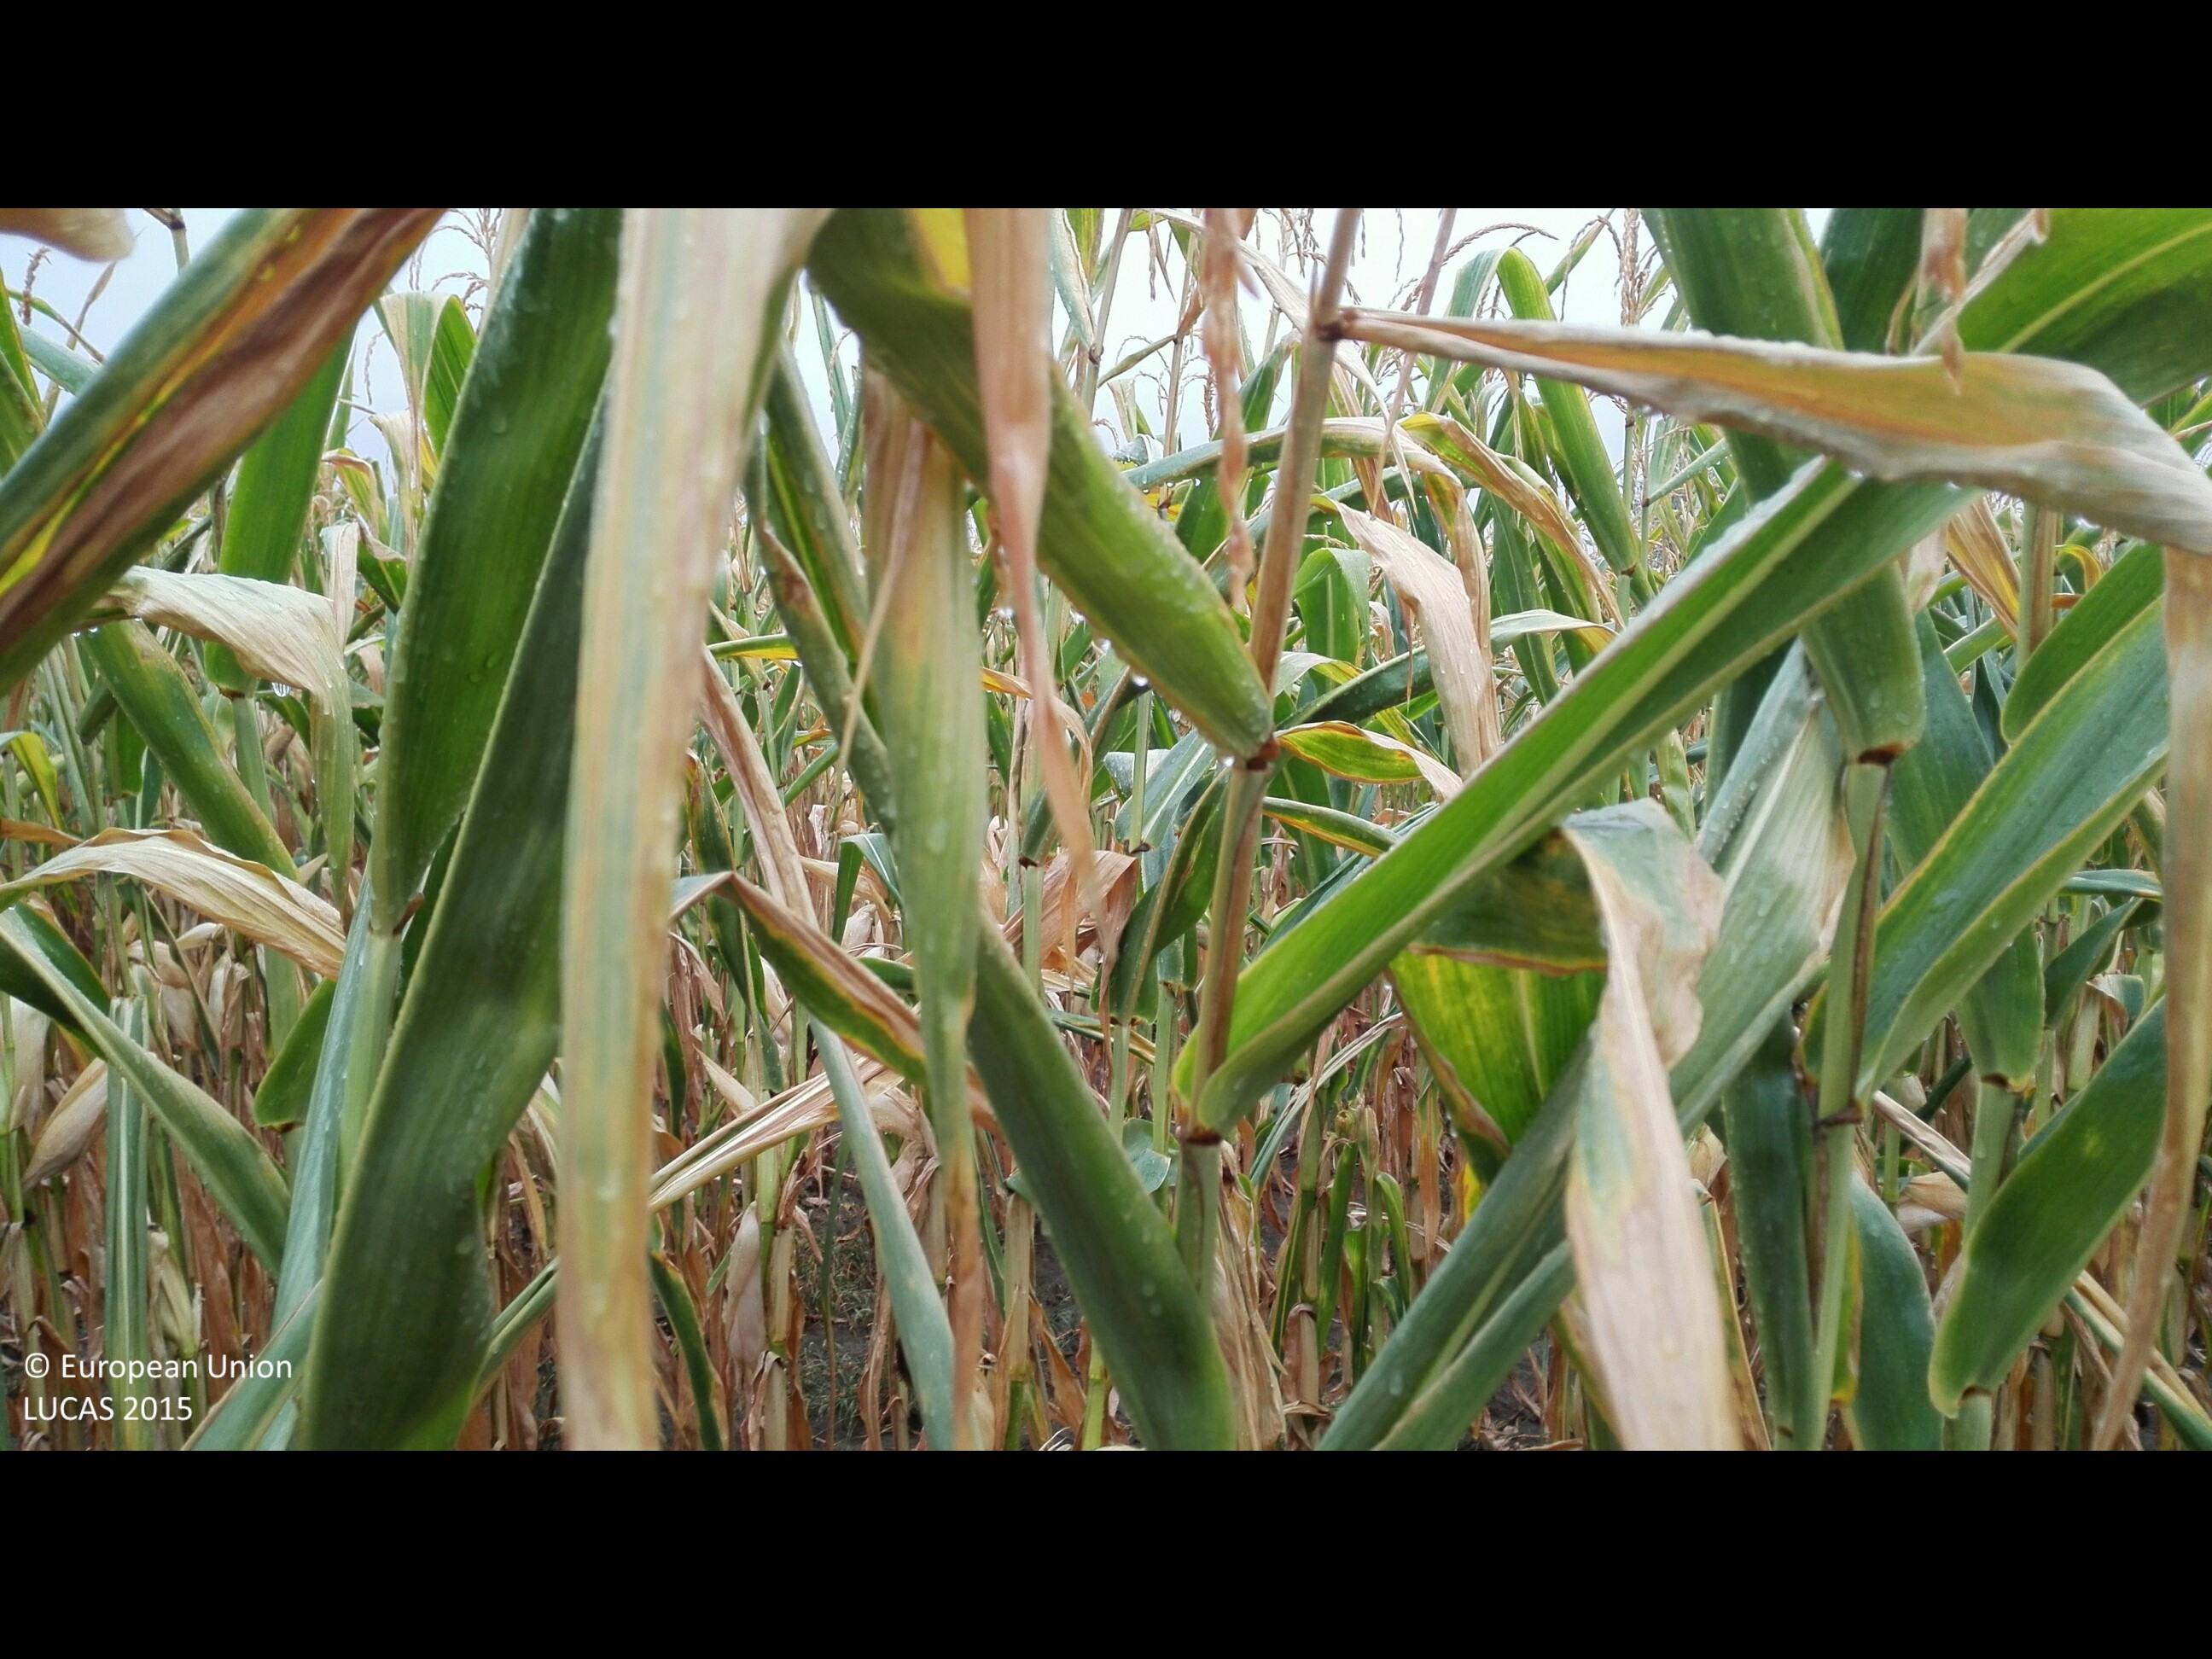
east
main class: Cropland
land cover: Maize
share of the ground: > 75 %
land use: Agriculture (excluding fallow land and kitchen gardens)
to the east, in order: Maize; Grass margins; Tracks; Grass margins; Common wheat; Inland fresh running water; Maize
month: August
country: HU
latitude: 47.3699
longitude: 21.7923
